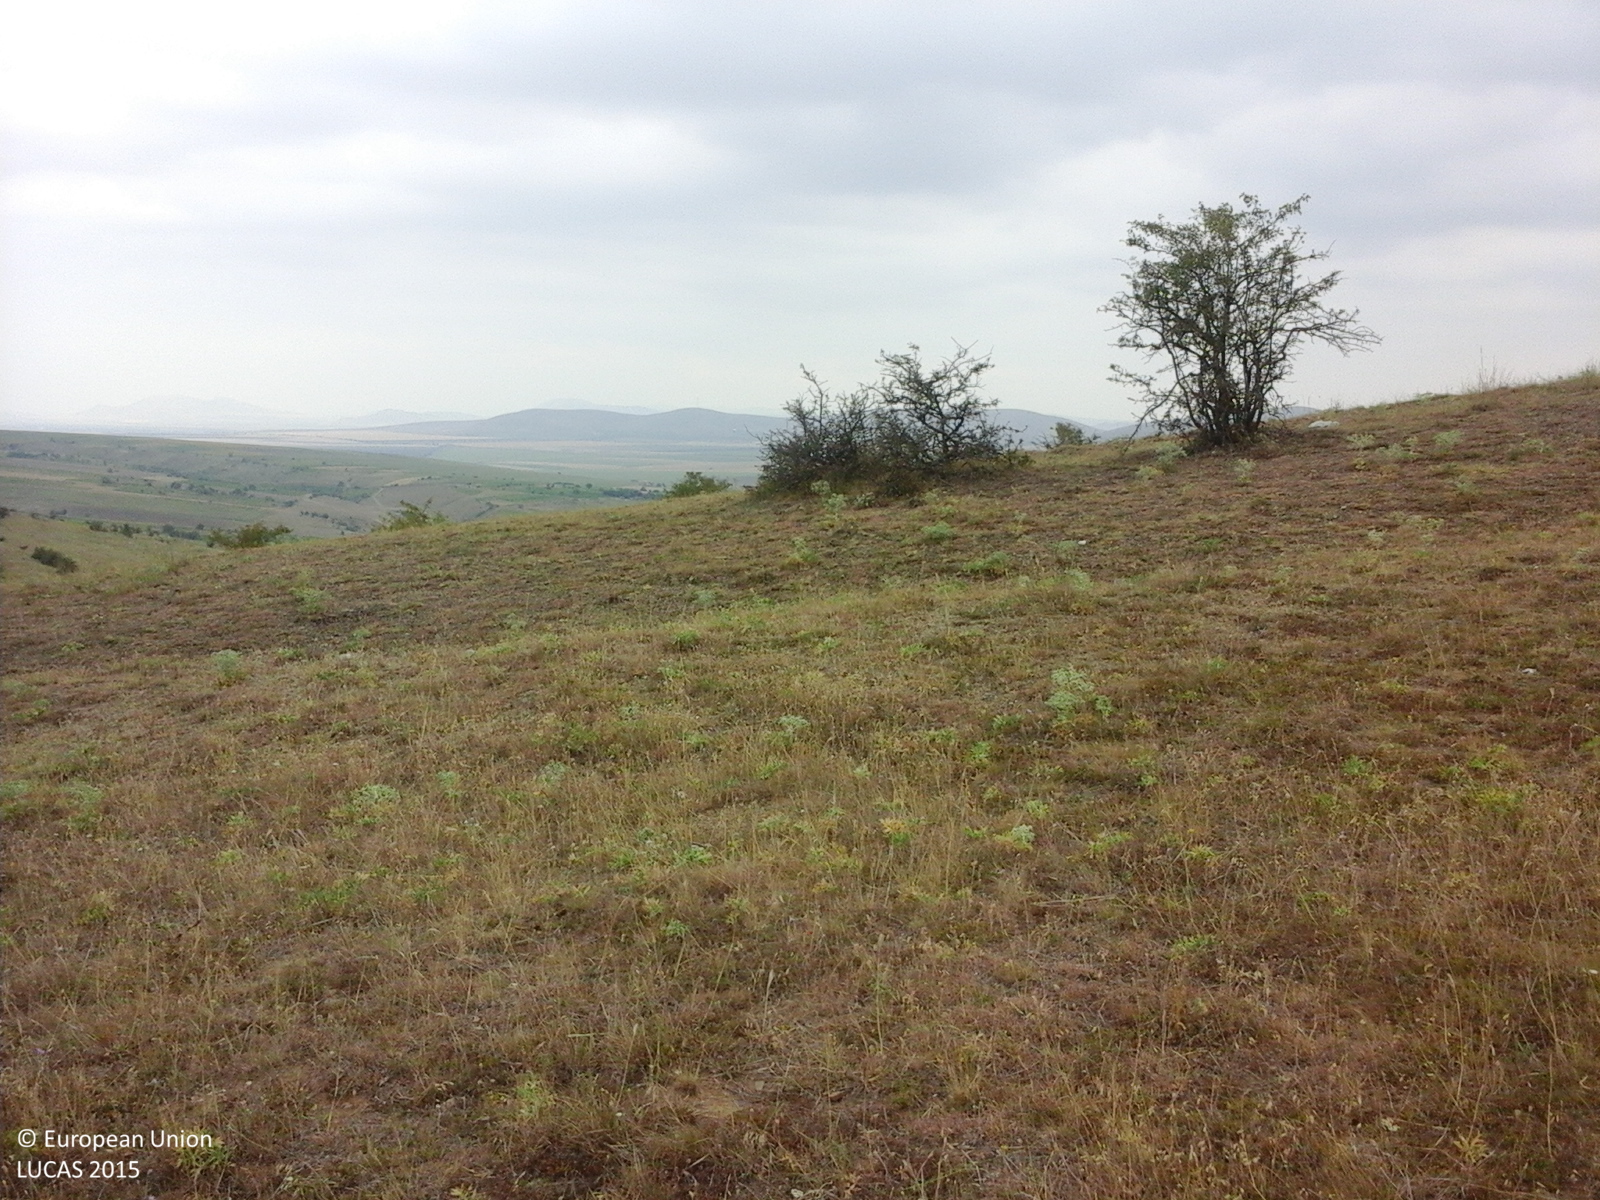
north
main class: Grassland
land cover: Grassland with sparse tree/shrub cover
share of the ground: > 75 %
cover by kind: herbaceous plants 95 %, broadleaved forest trees 5 %
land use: Agriculture (excluding fallow land and kitchen gardens)
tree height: < 5 m
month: July
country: RO
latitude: 44.9425
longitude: 28.2818
